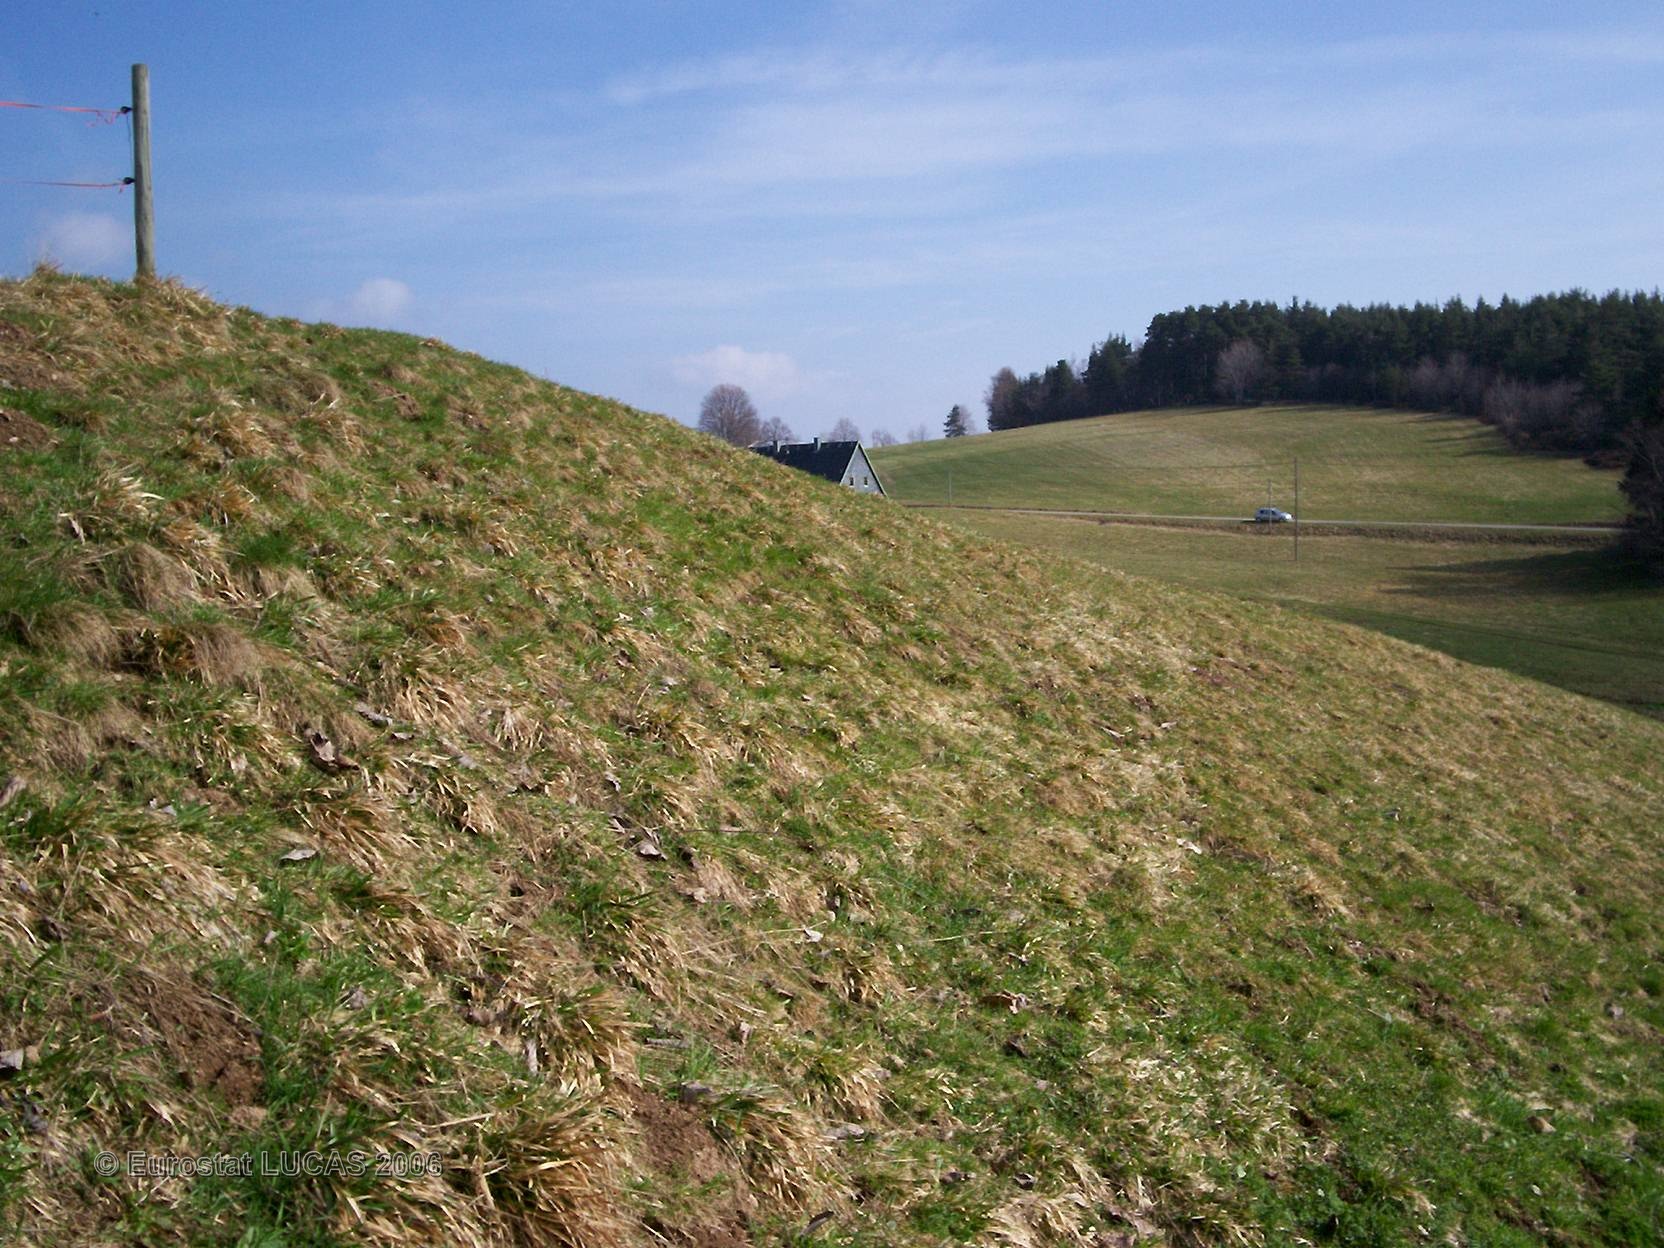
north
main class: Grassland
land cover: Grassland with sparse tree/shrub cover
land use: Agriculture (excluding fallow land and kitchen gardens)
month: April
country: FR
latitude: 48.0958
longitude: 7.1142
